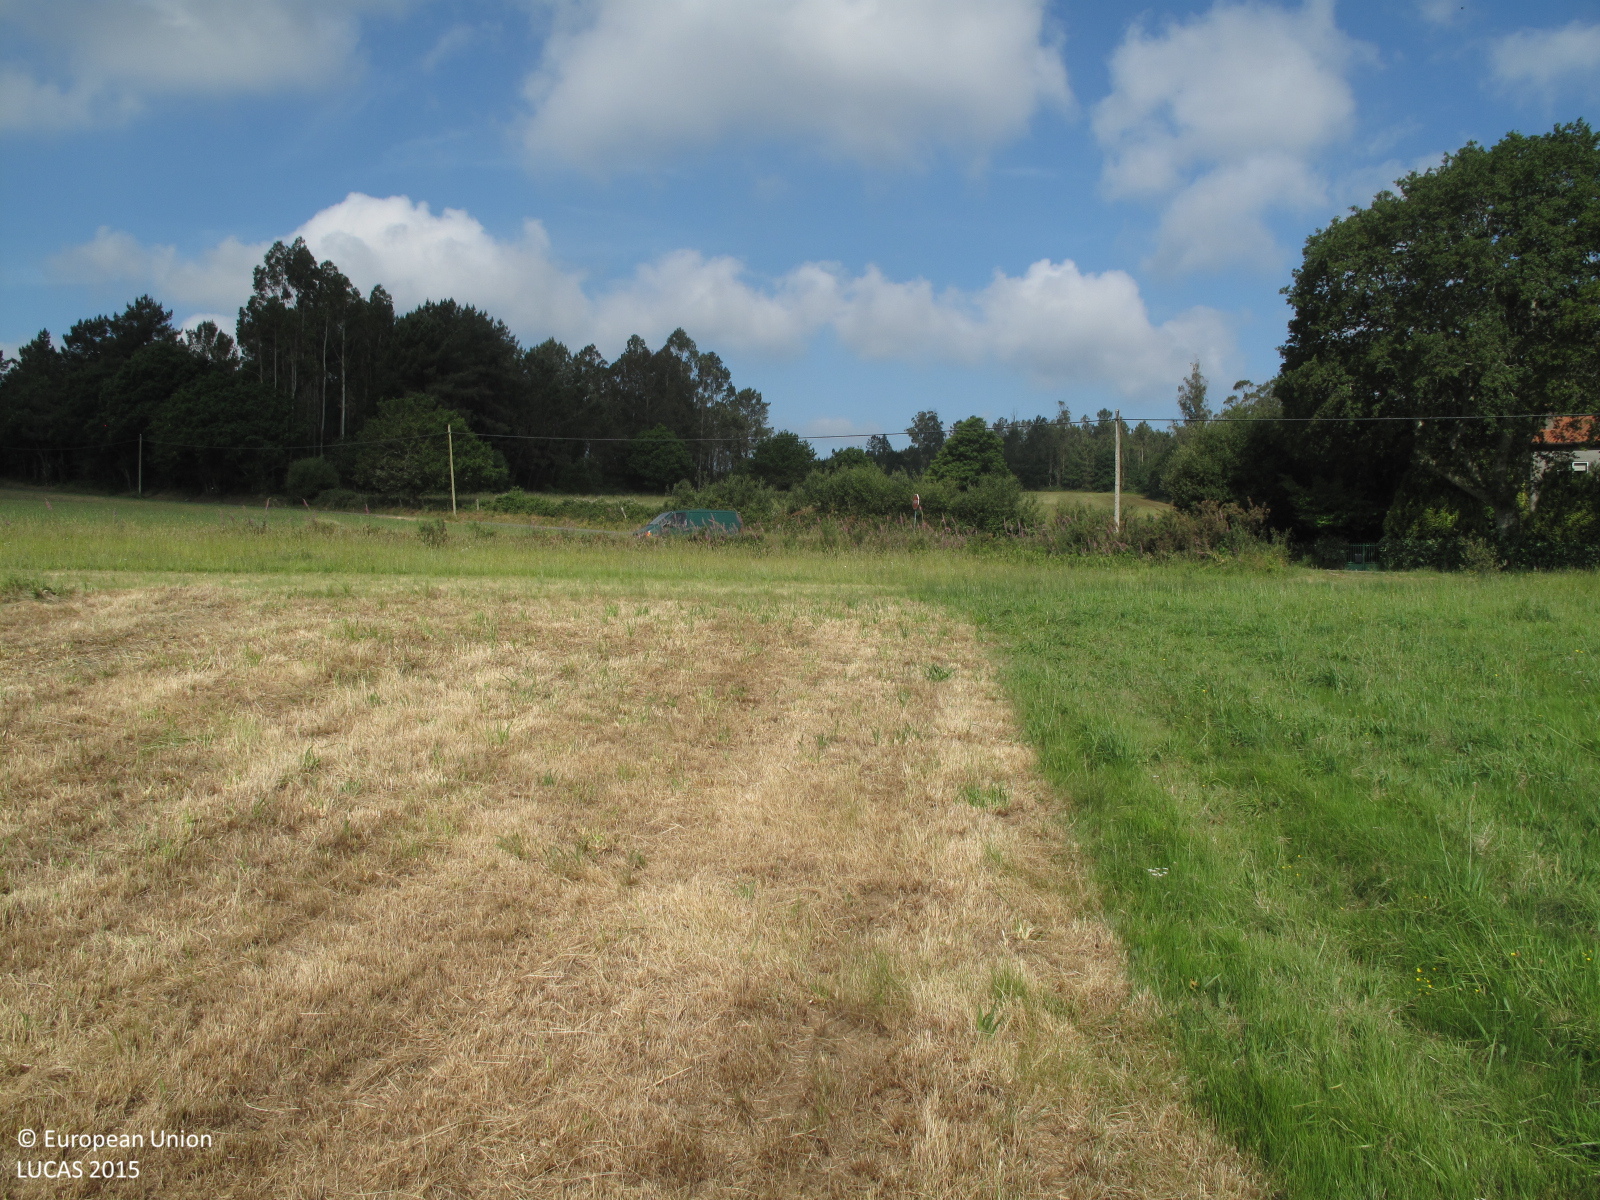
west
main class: Grassland
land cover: Grassland without tree/shrub cover
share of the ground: > 75 %
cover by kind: herbaceous plants 100 %
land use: Agriculture (excluding fallow land and kitchen gardens)
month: June
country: ES
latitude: 42.9374
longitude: -8.4472
